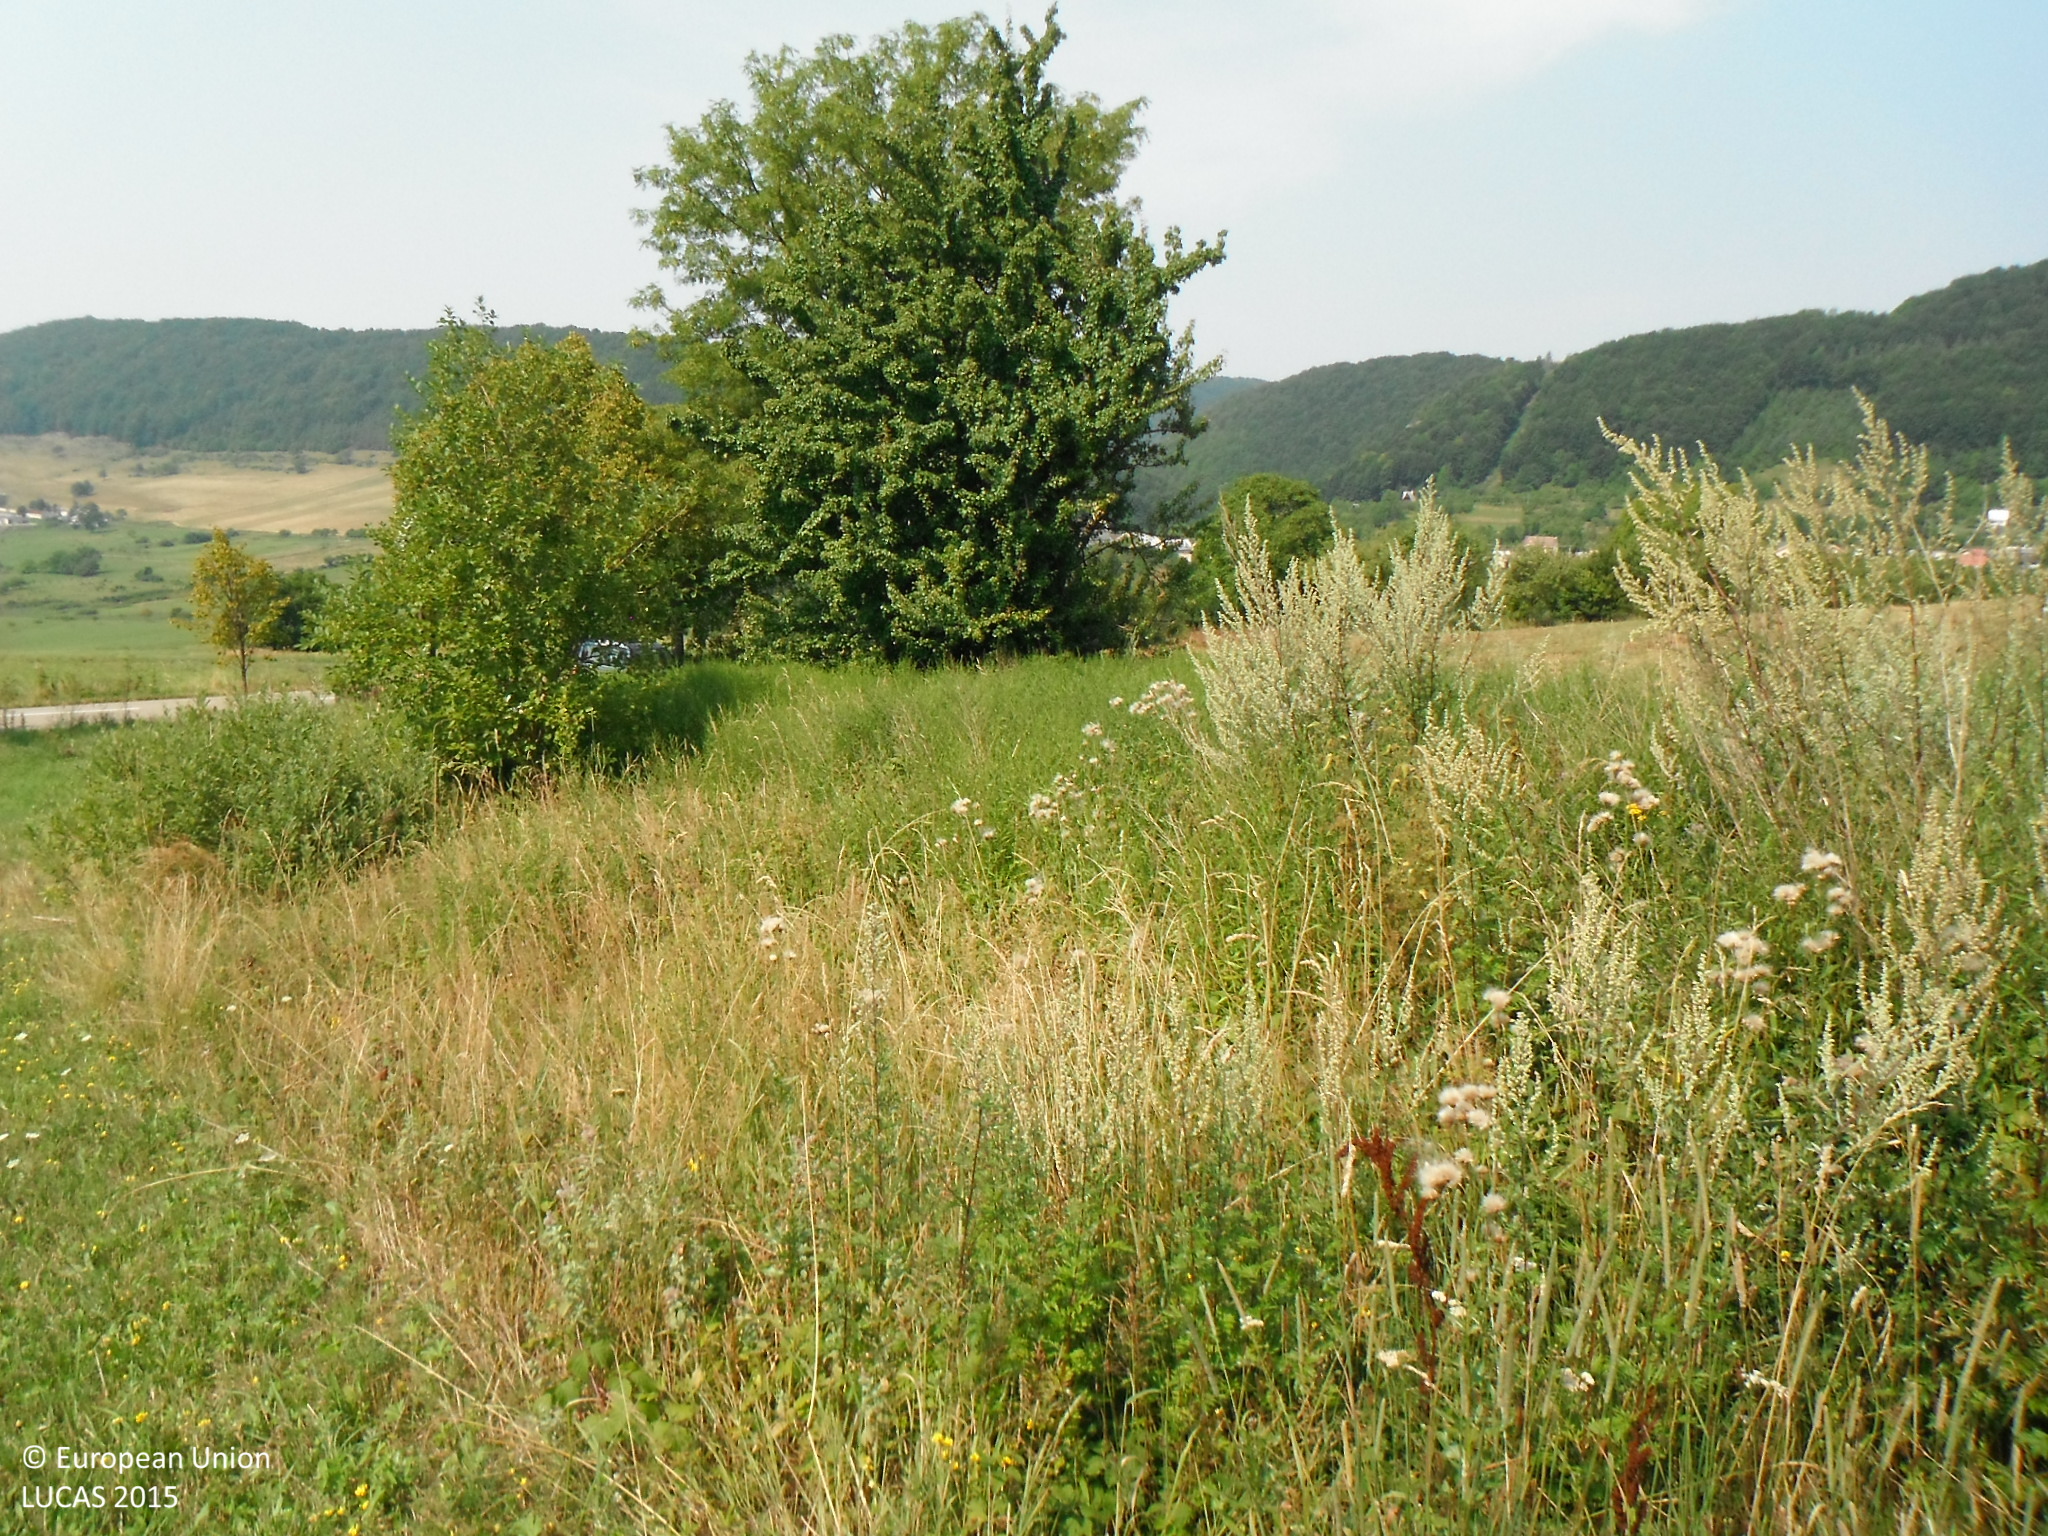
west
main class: Grassland
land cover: Grassland without tree/shrub cover
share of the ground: > 75 %
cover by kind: herbaceous plants 100 %
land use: Agriculture (excluding fallow land and kitchen gardens)
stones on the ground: 10 - 25 %
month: August
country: SK
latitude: 48.9485
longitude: 18.4423
